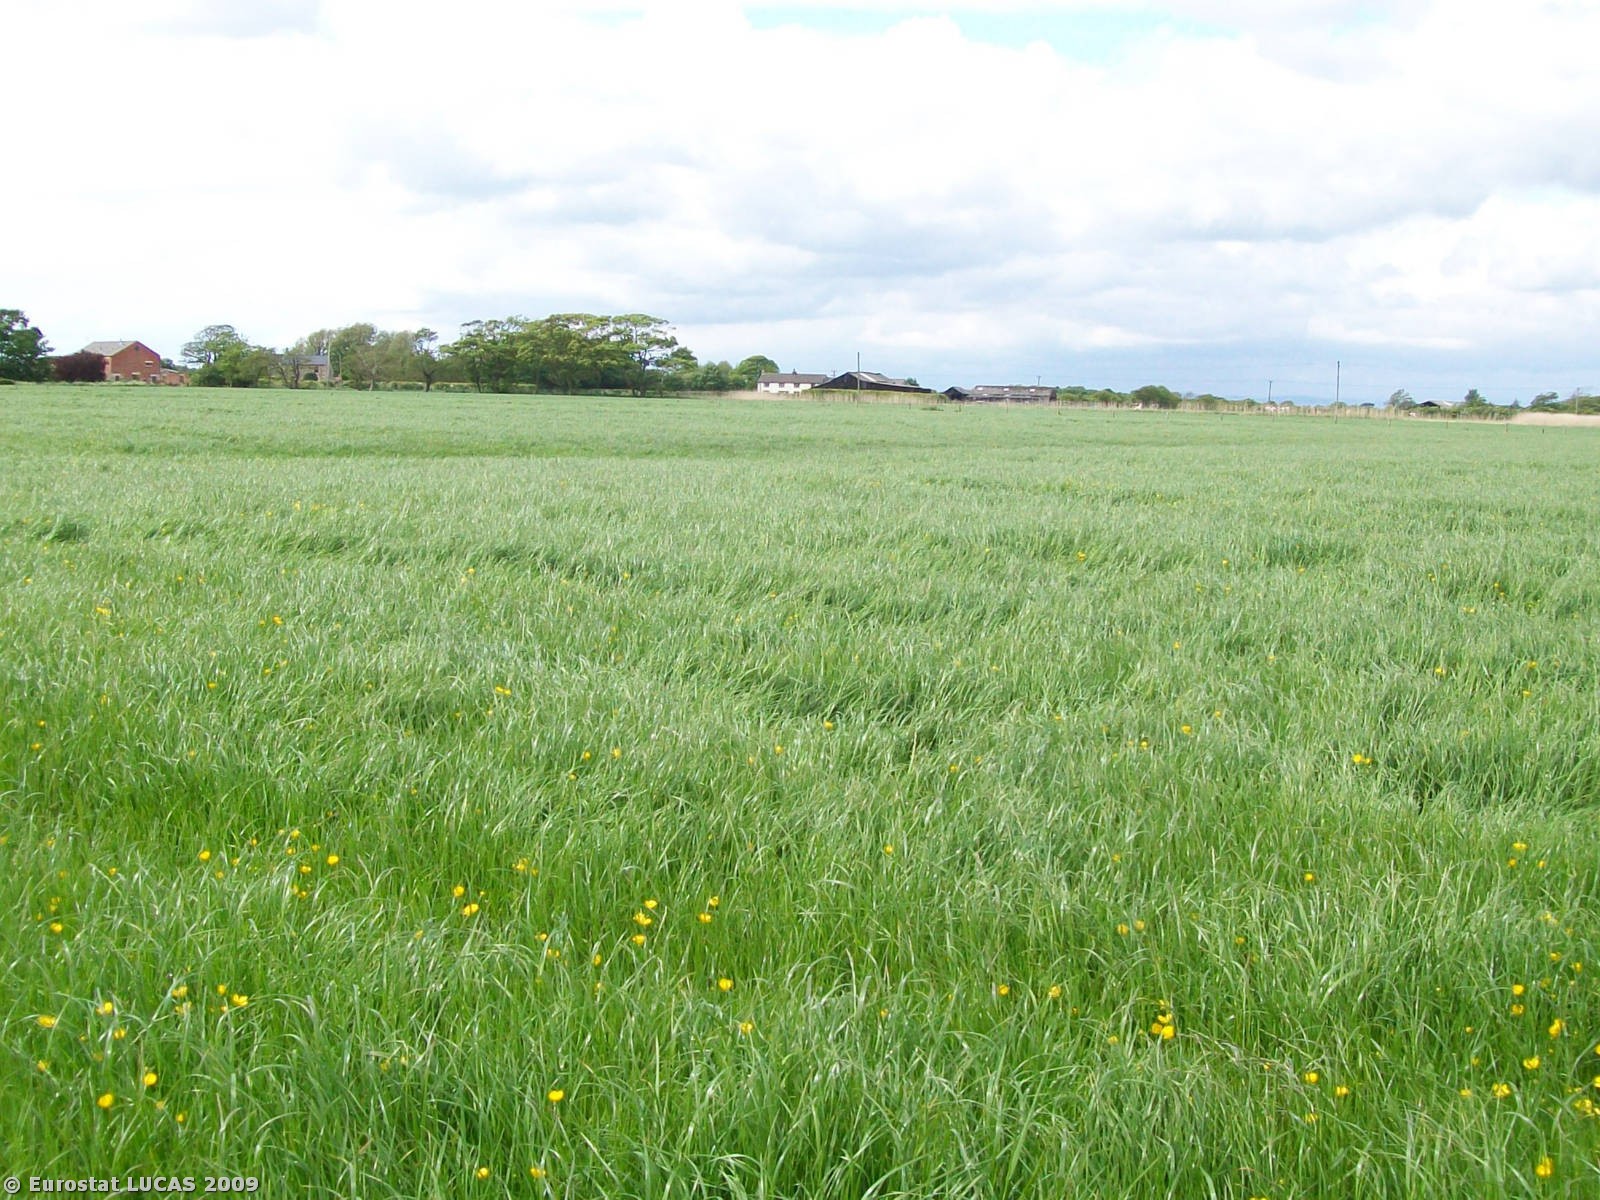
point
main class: Grassland
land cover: Grassland without tree/shrub cover
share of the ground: 25 - 50 %
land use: Agriculture (excluding fallow land and kitchen gardens)
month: May
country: GB
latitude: 53.9247
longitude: -2.9403
